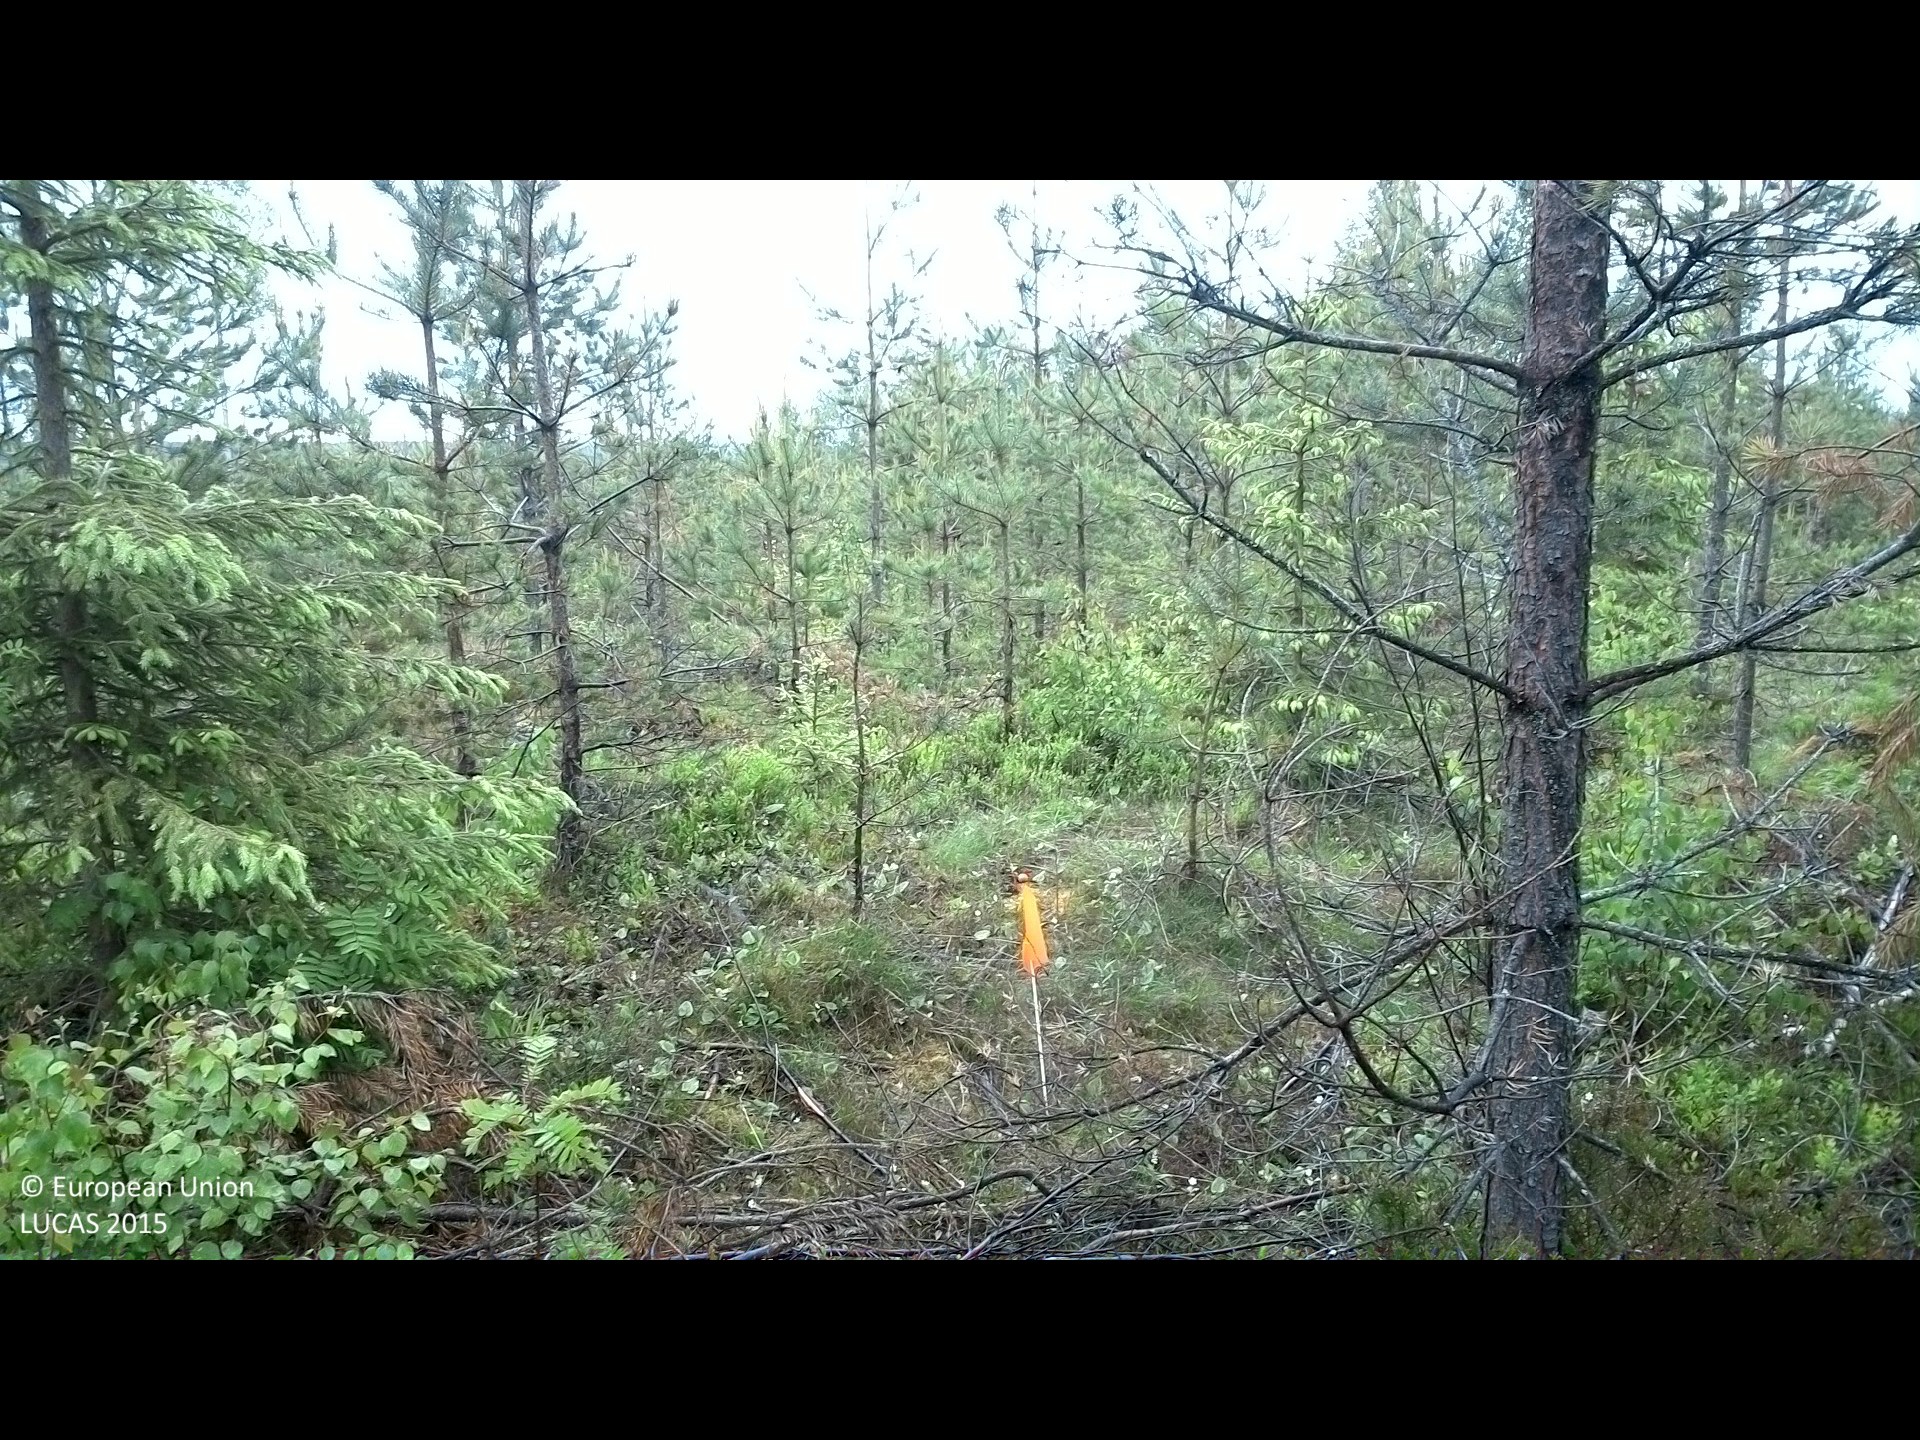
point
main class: Woodland
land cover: Pine dominated coniferous woodland
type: boreal forest
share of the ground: 25 - 50 %
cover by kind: herbaceous plants 40 %, shrubs 30 %, coniferous forest trees 25 %, broadleaved forest trees 5 %
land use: Forestry
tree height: < 5 m
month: June
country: SE
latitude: 61.8988
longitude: 17.1575
